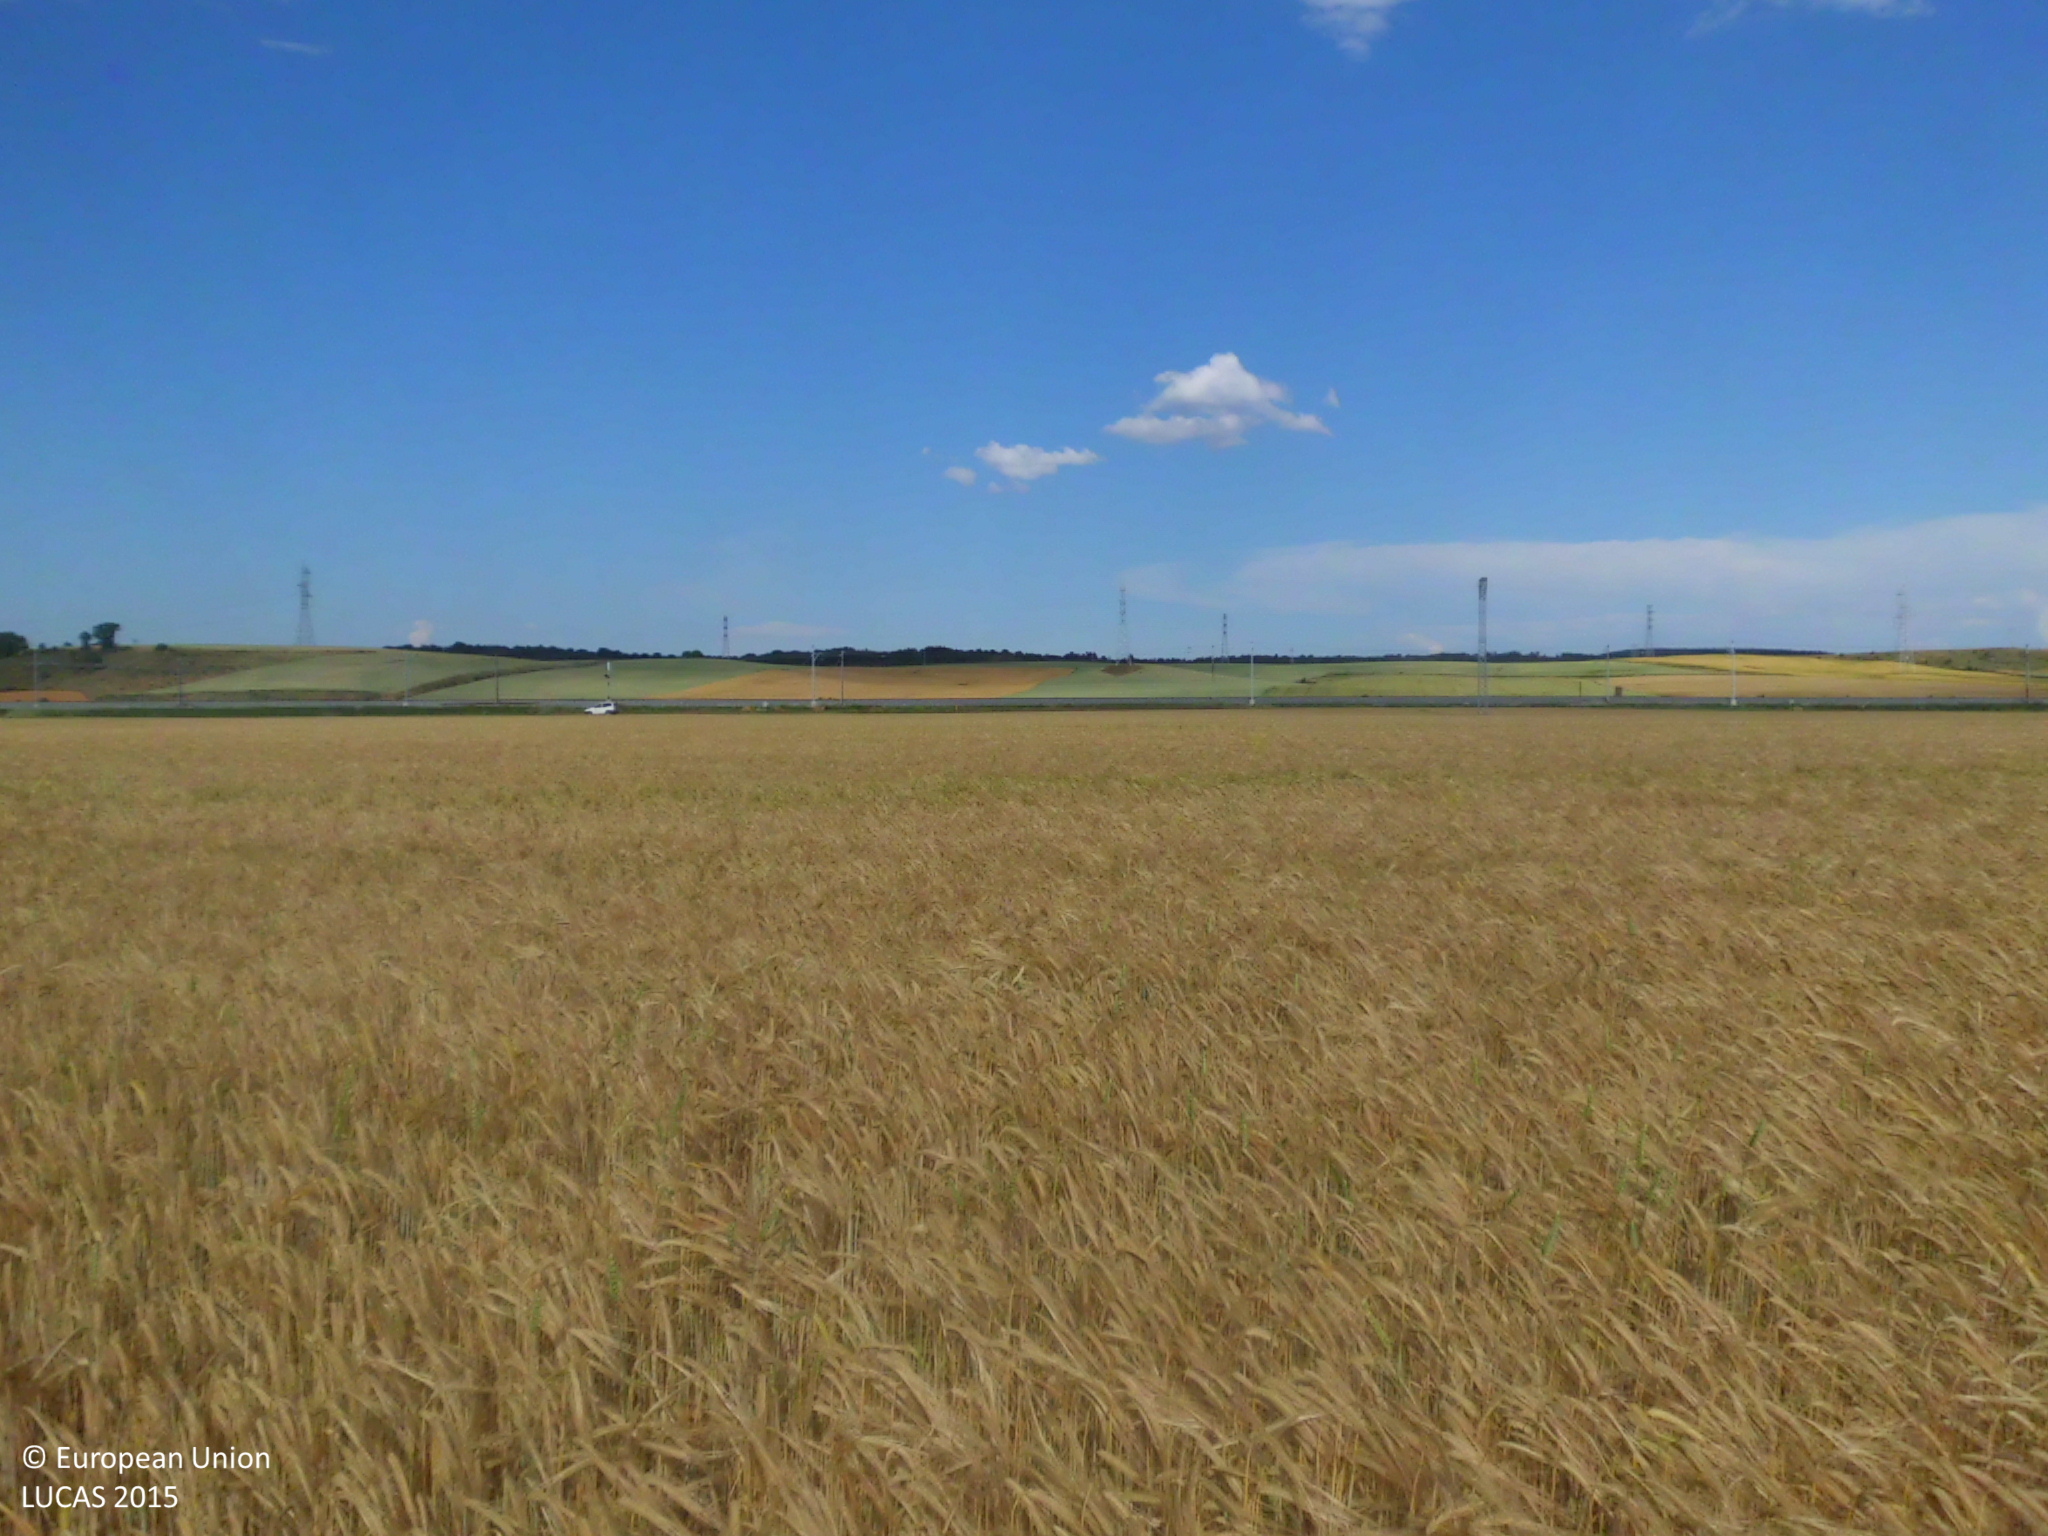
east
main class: Cropland
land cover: Barley
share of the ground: > 75 %
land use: Agriculture (excluding fallow land and kitchen gardens)
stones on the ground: < 10 %
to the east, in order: Barley; Electric lines; Barley; Paved roads, cycling and walking lanes; Grassland without tree/shrub cover; Electric lines; Railways; Electric lines; Grass margins; Spontaneously vegetated surfaces
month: June
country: ES
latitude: 42.5020
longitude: -4.3717
